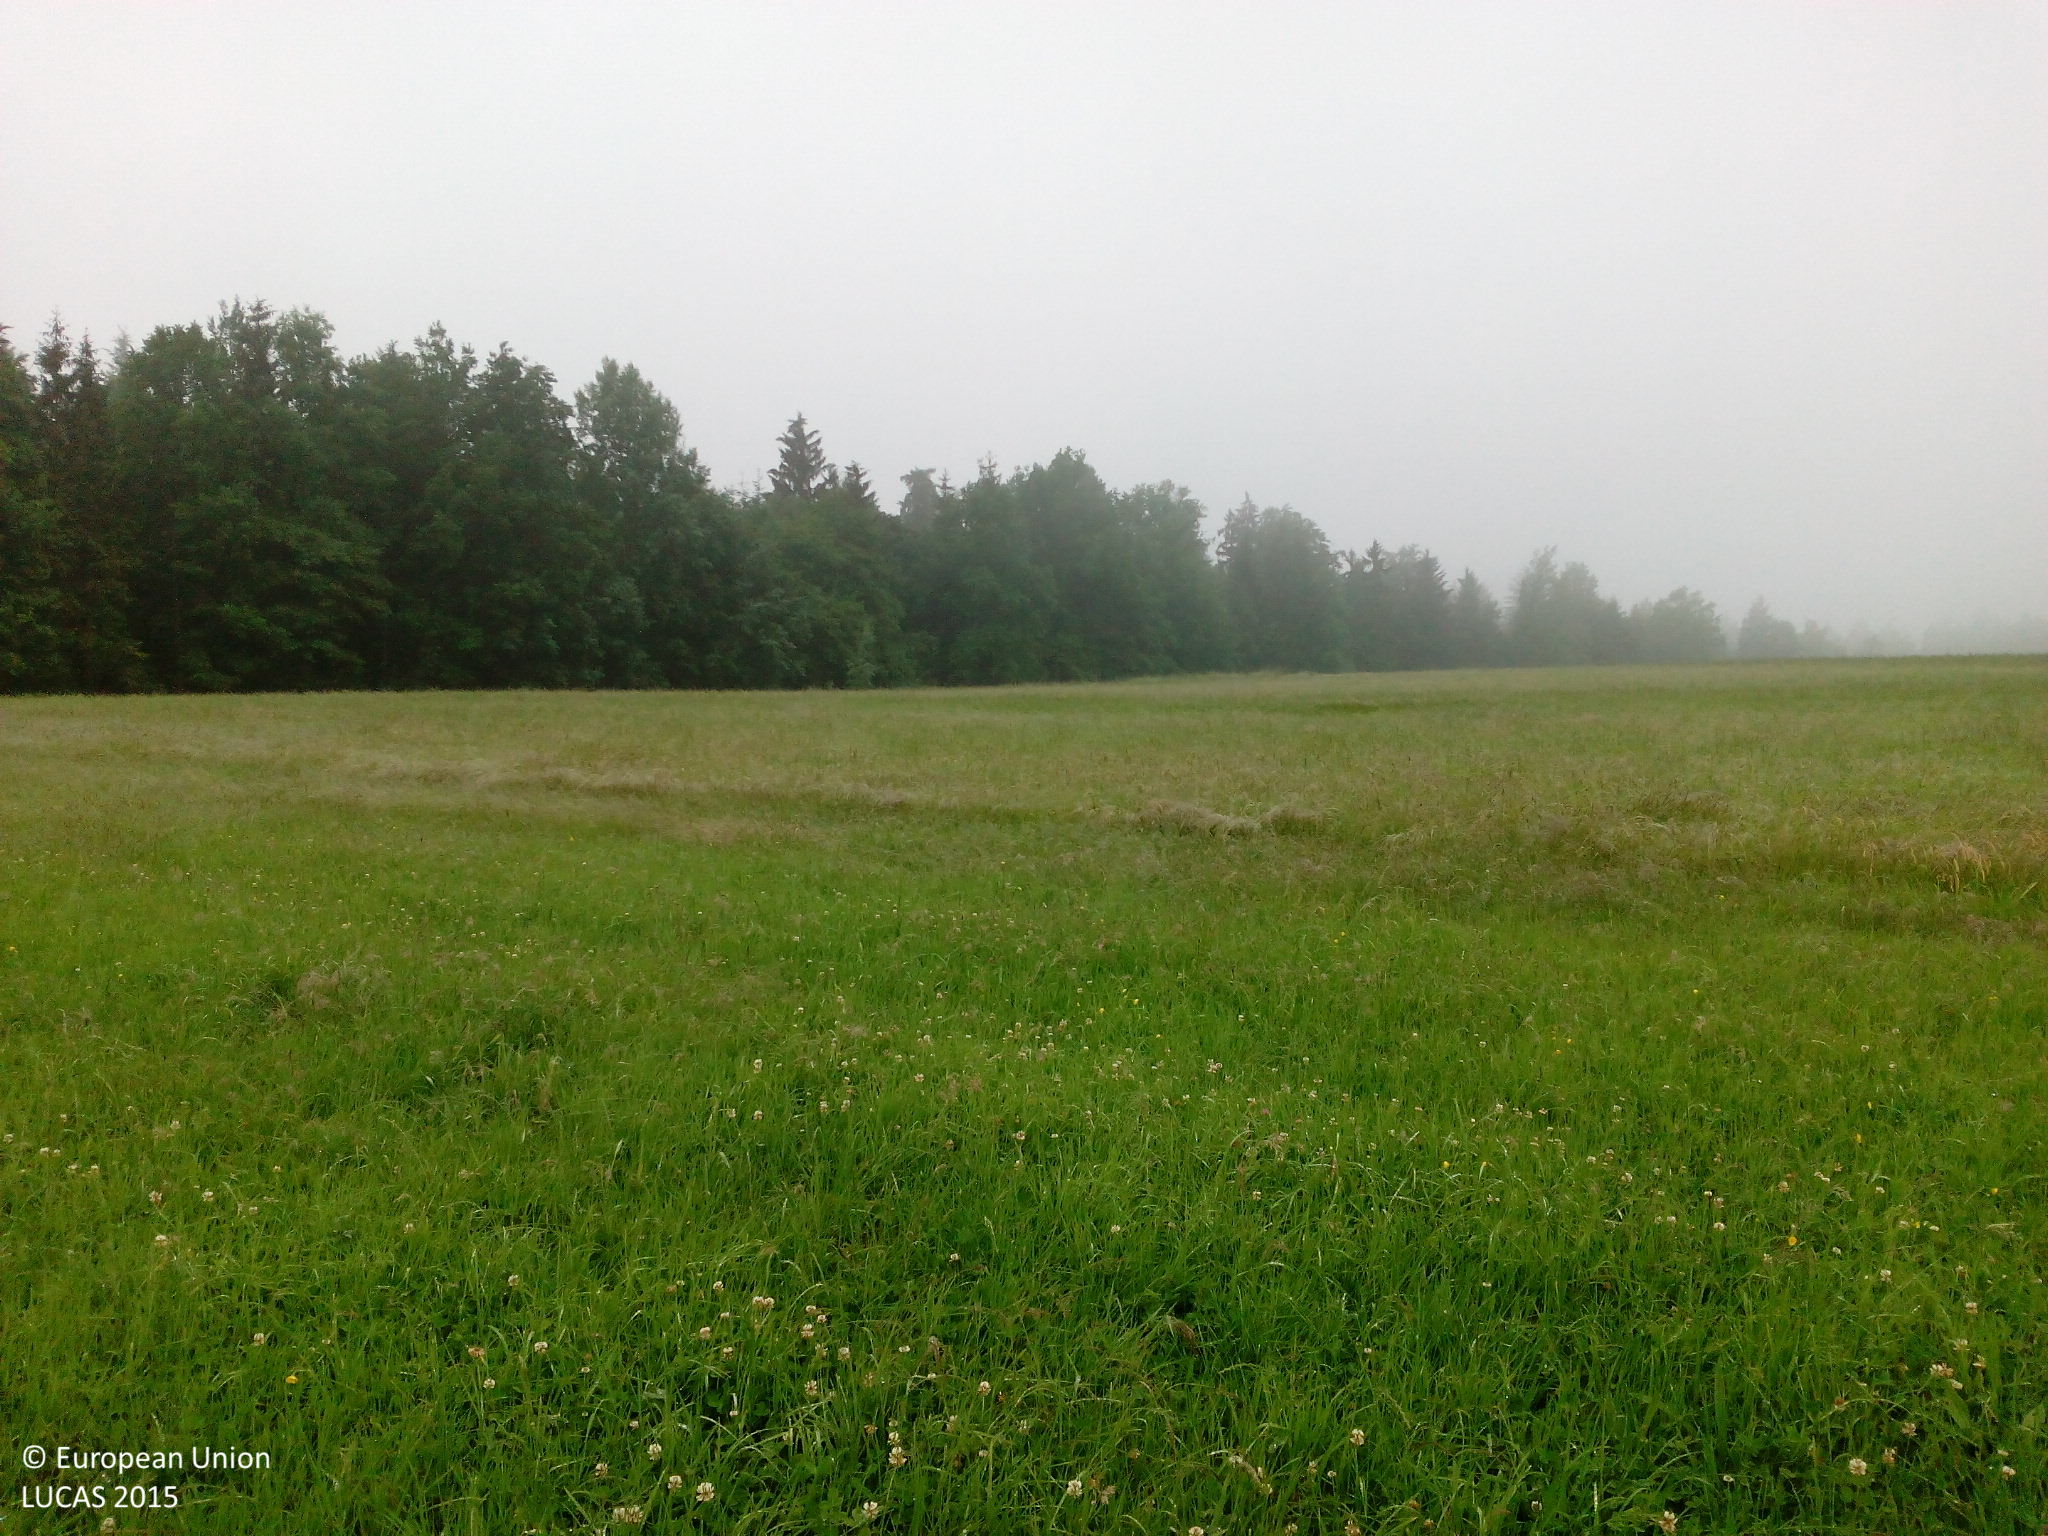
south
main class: Grassland
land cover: Grassland without tree/shrub cover
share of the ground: > 75 %
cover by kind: herbaceous plants 100 %
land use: Agriculture (excluding fallow land and kitchen gardens)
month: June
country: DE
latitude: 50.0845
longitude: 11.4950
